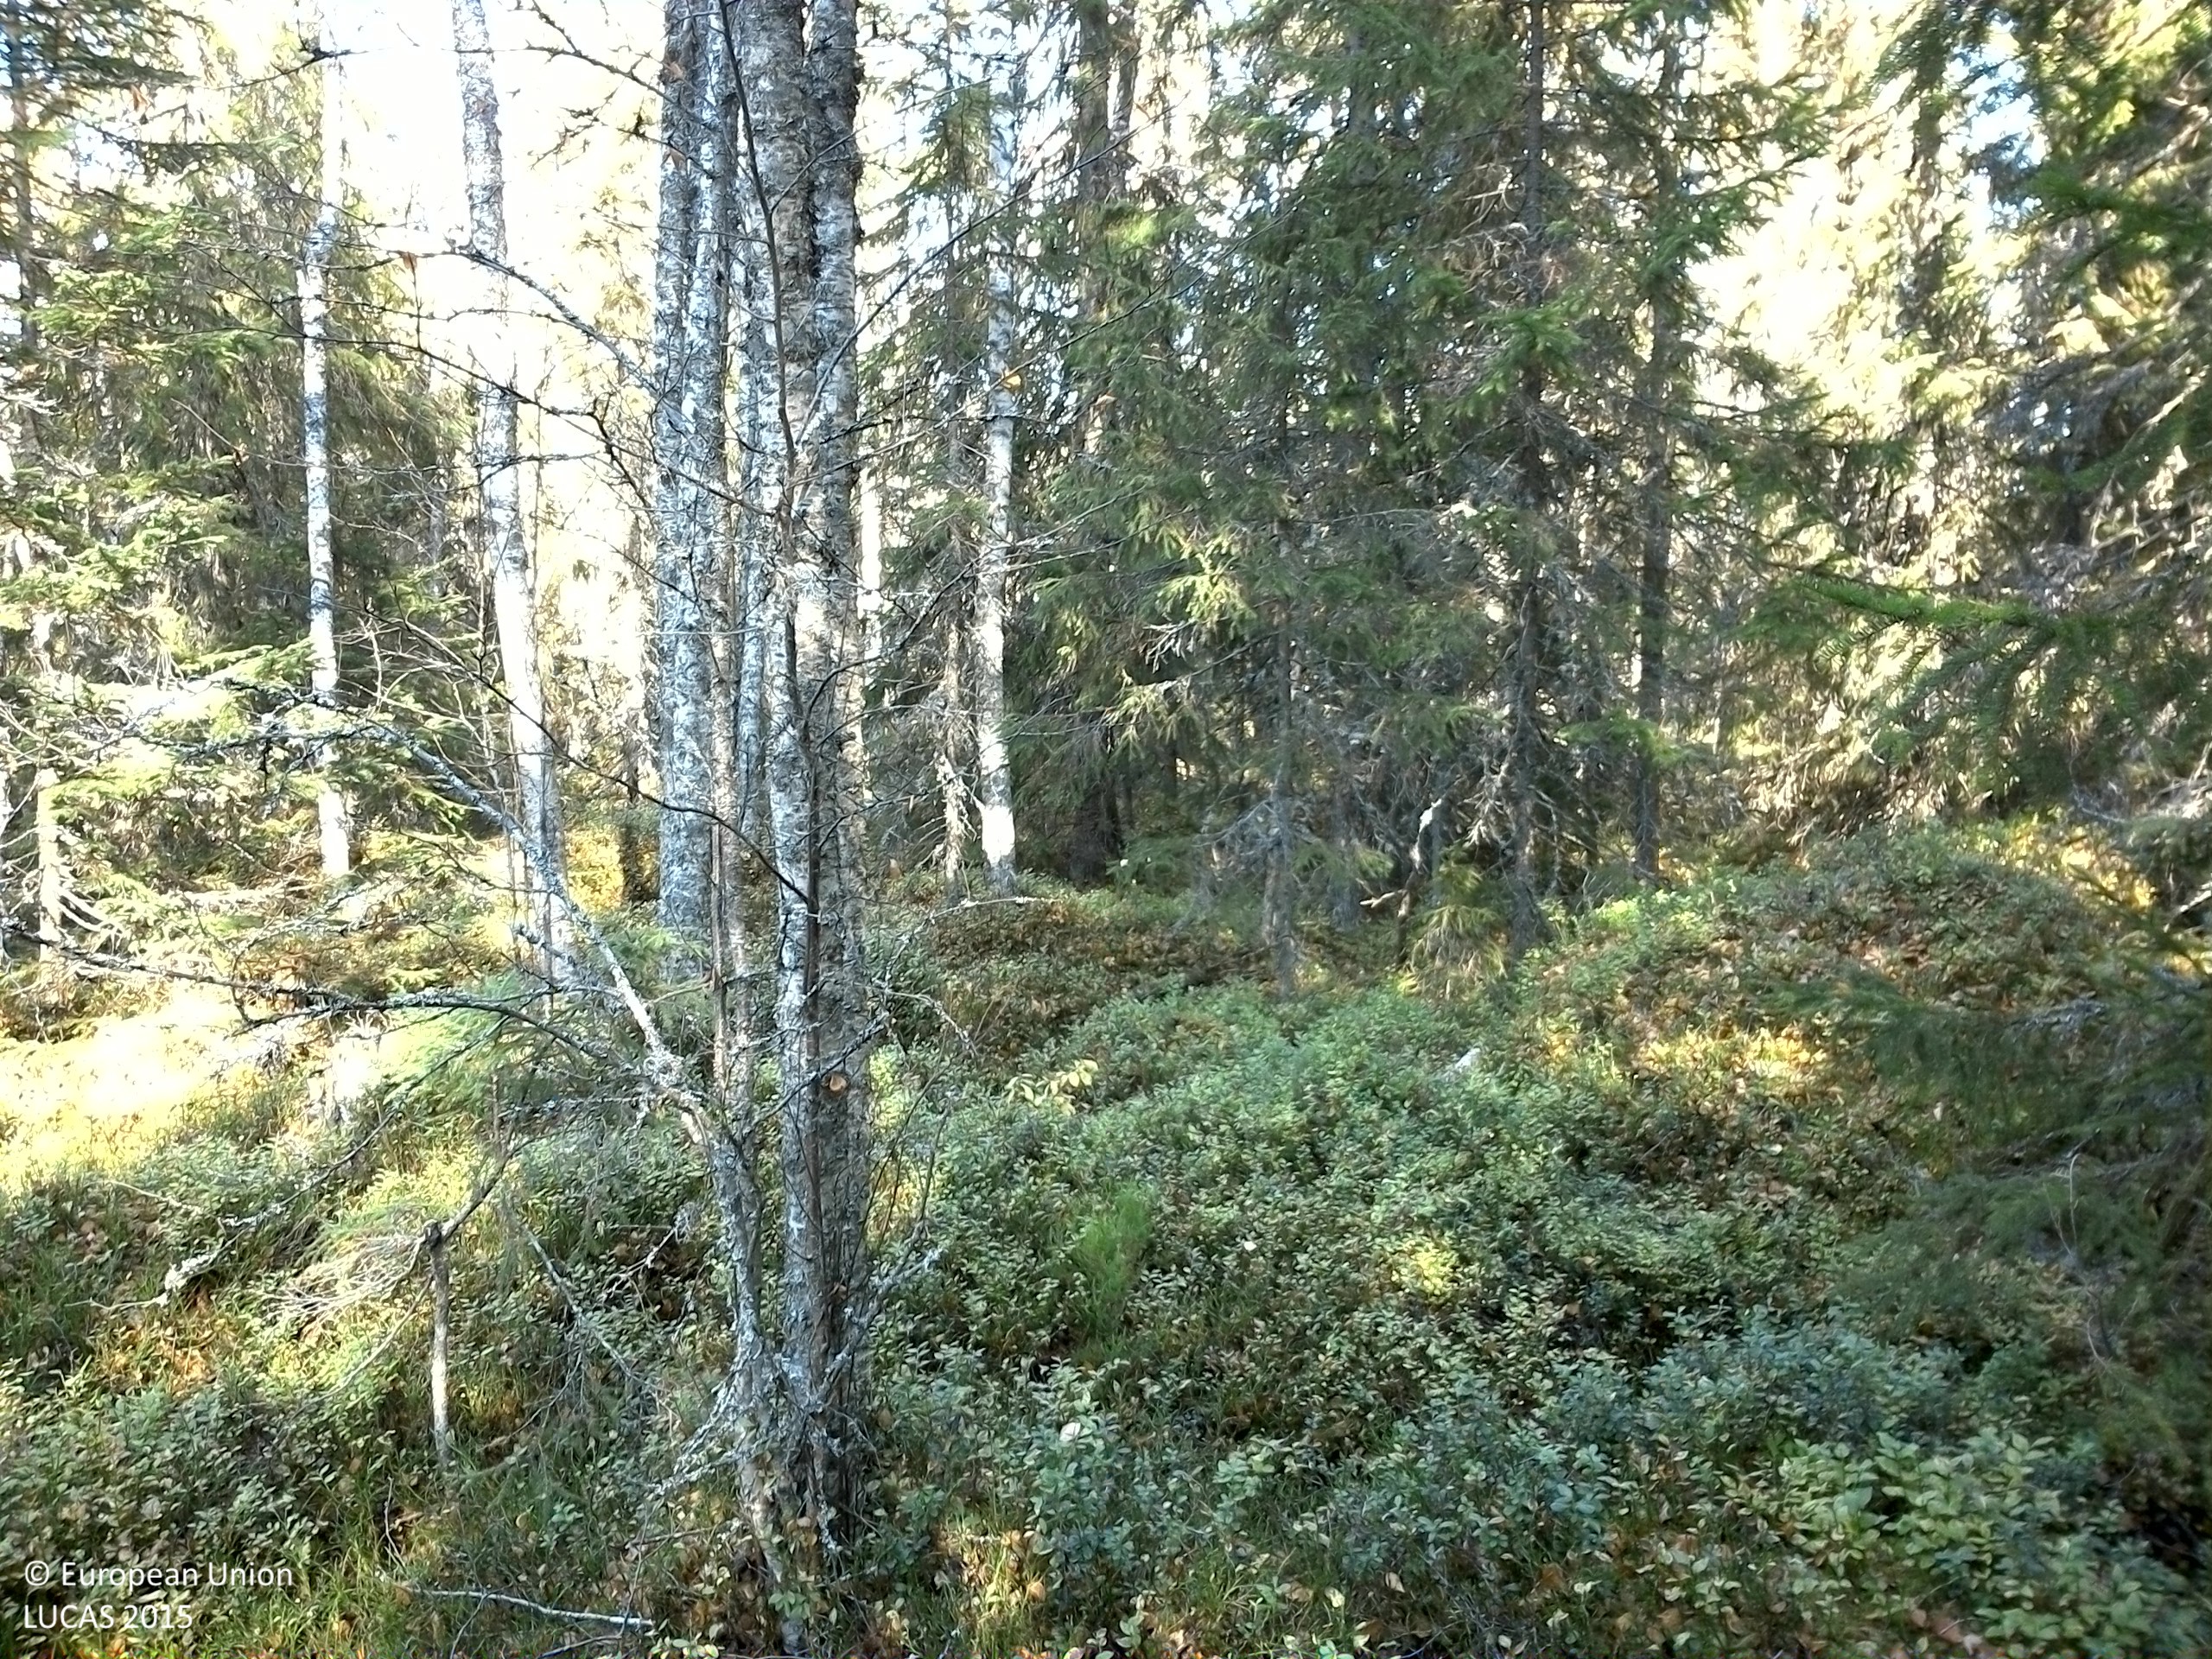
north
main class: Woodland
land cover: Spruce dominated mixed woodland
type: boreal forest
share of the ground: 50 - 75 %
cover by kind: coniferous forest trees 50 %, shrubs 25 %, broadleaved forest trees 20 %, lichens and mosses 5 %
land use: Forestry
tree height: > 5 m
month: October
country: SE
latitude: 61.2366
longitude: 15.2945
